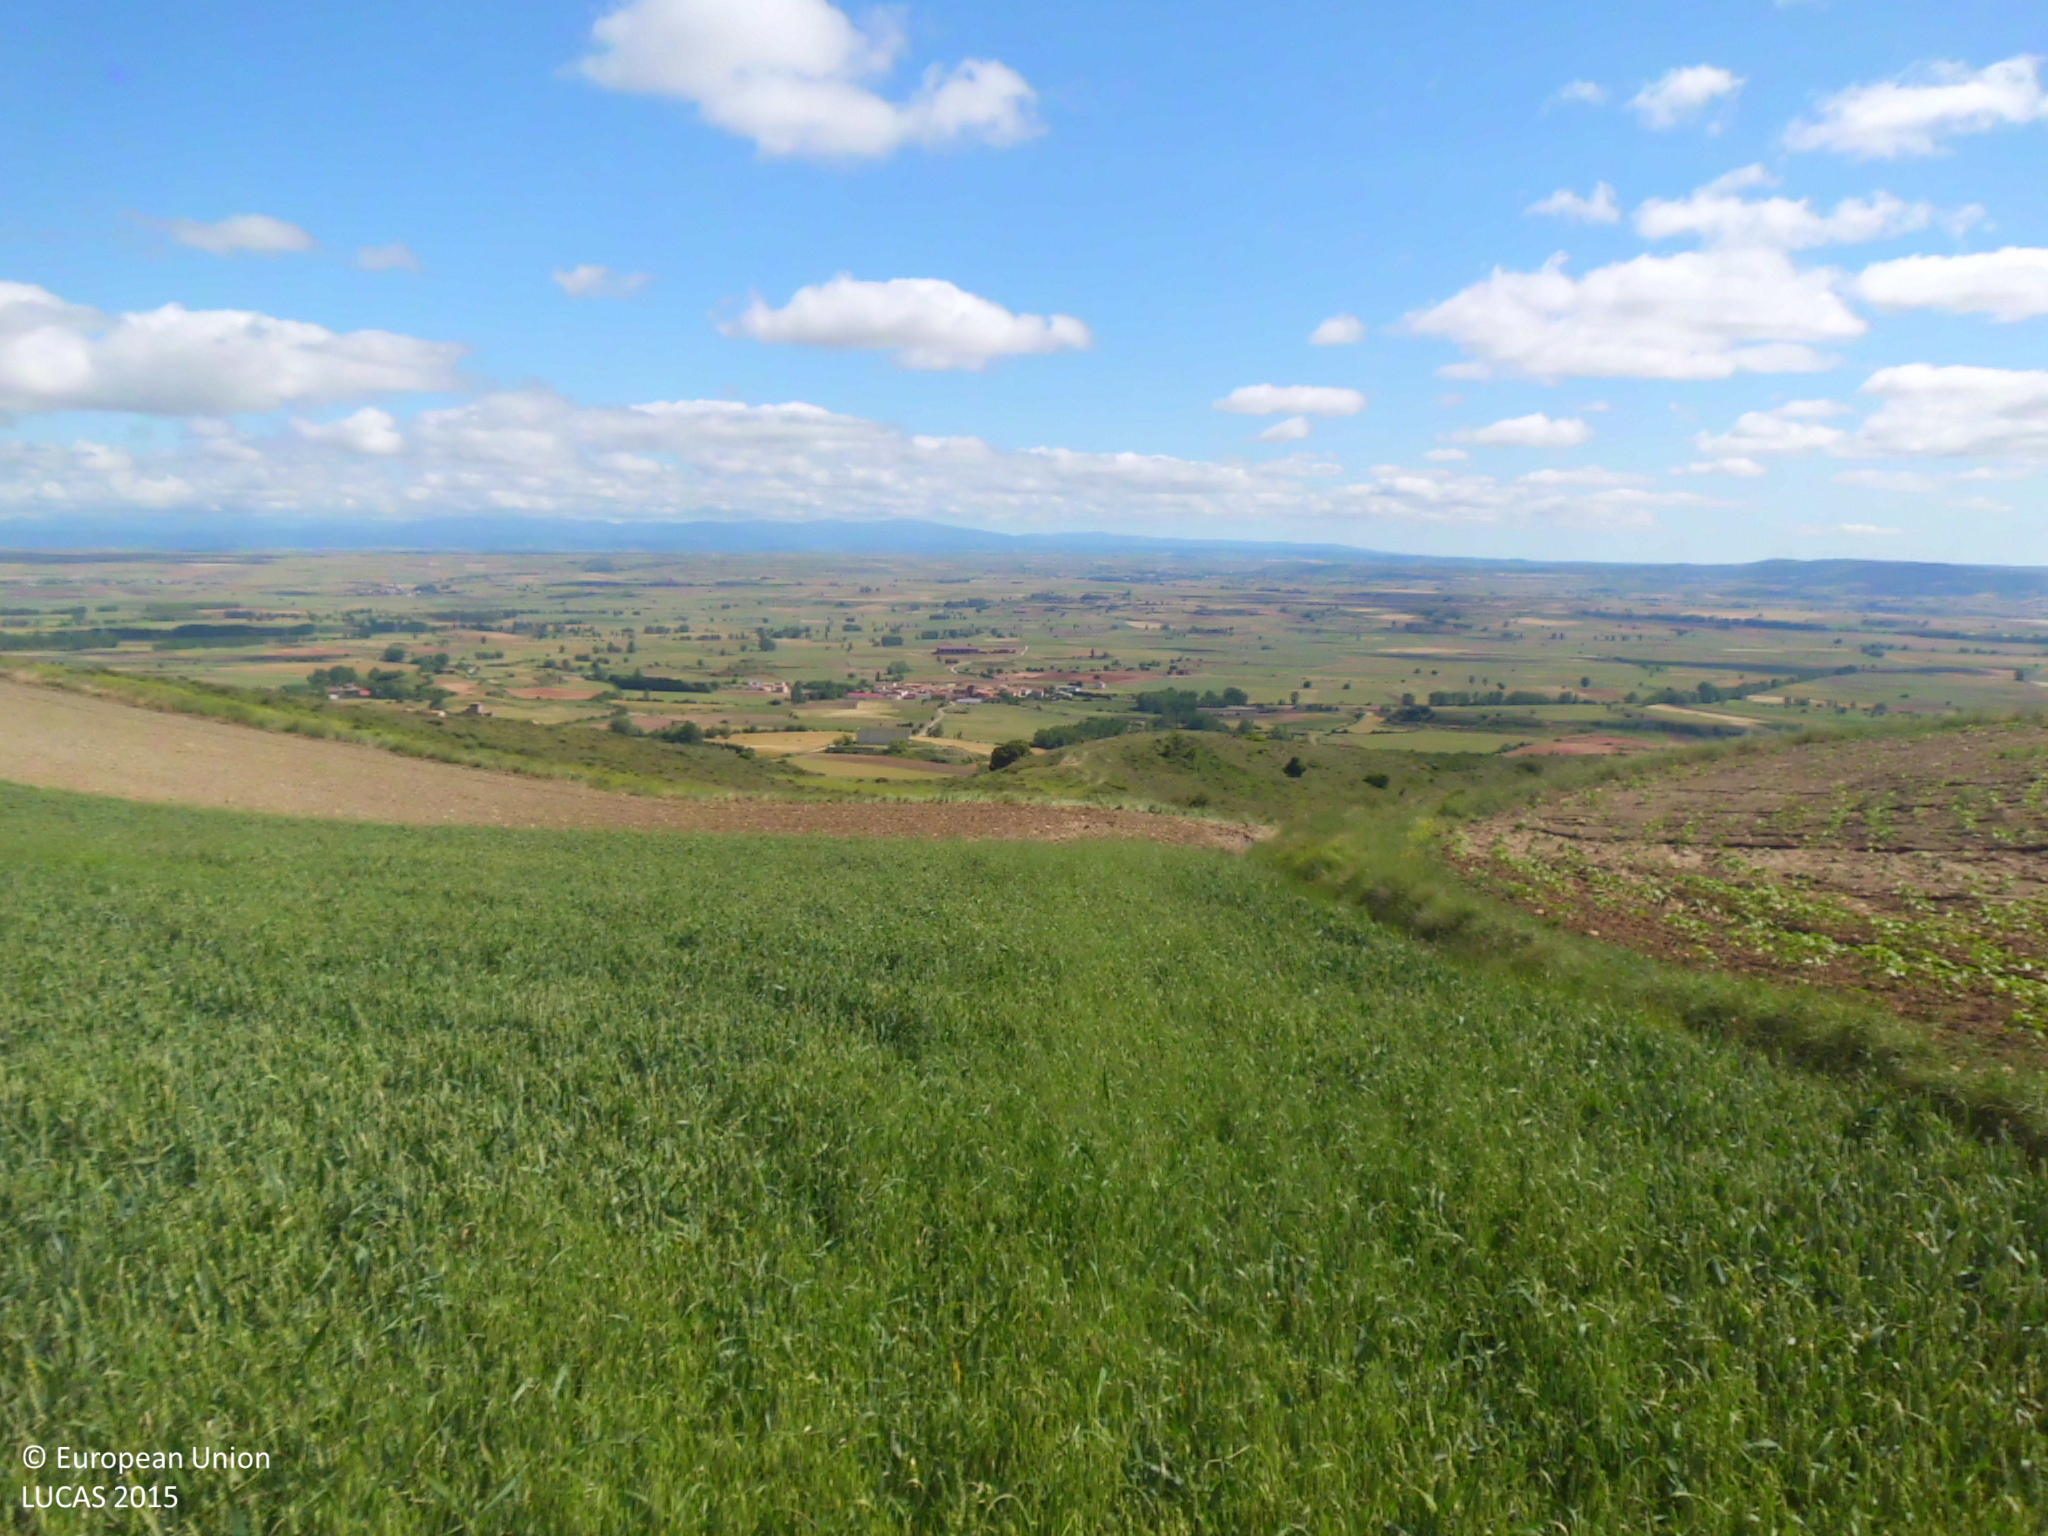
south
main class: Cropland
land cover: Common wheat
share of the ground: > 75 %
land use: Agriculture (excluding fallow land and kitchen gardens)
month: June
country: ES
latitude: 42.6863
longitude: -3.3005
